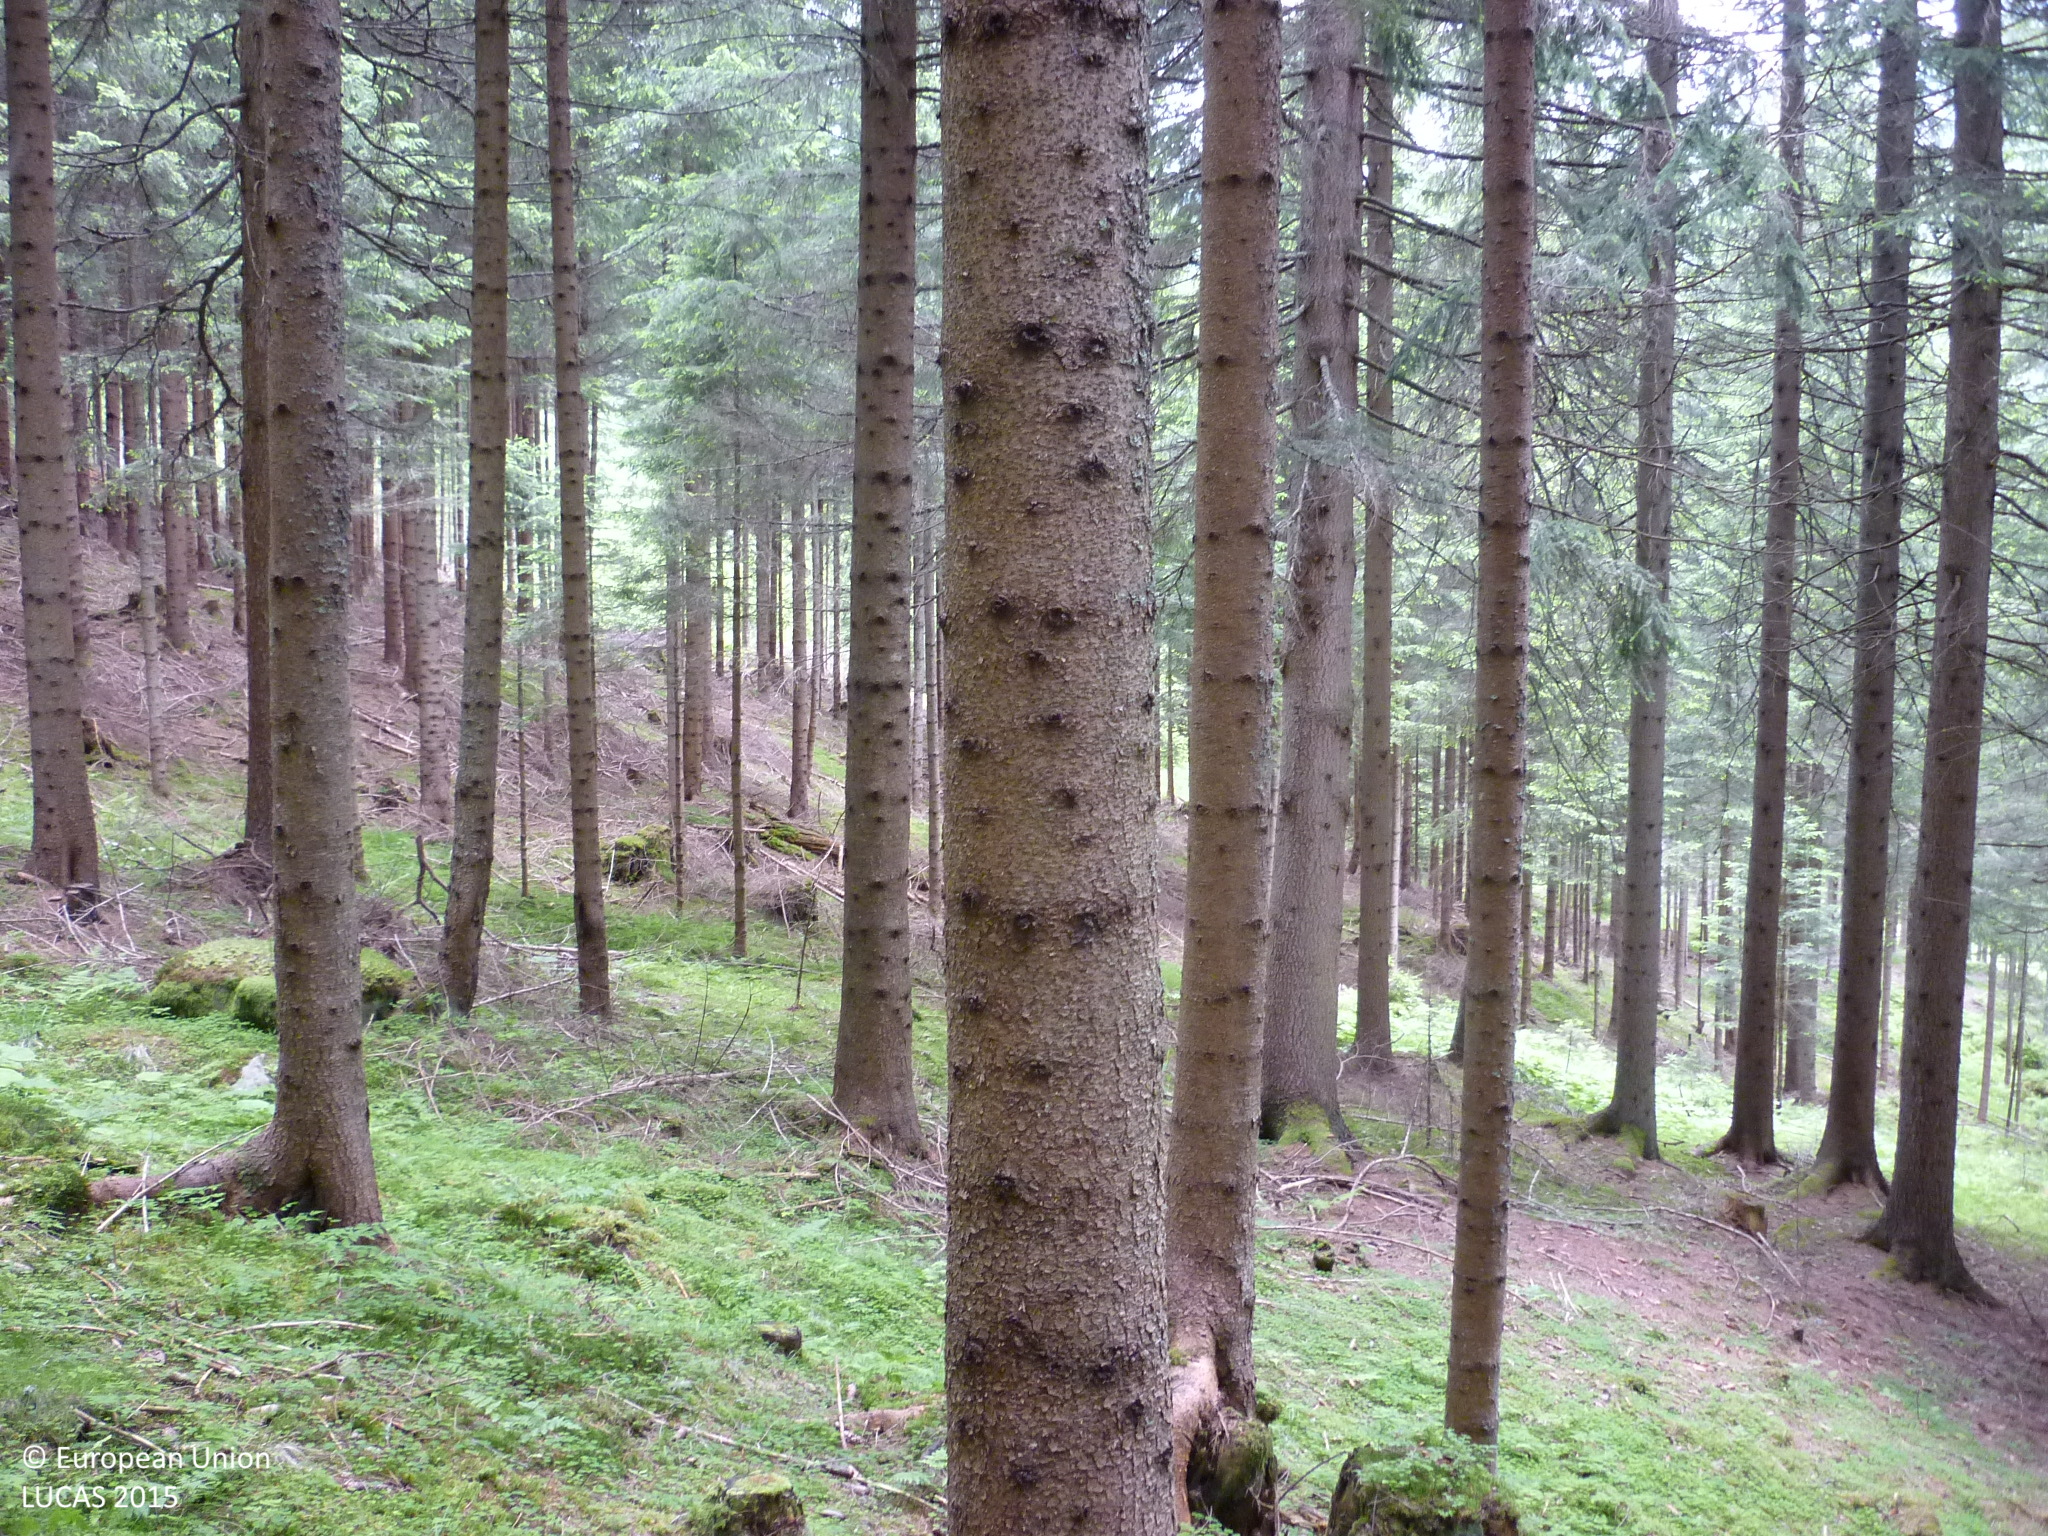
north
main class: Woodland
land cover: Spruce dominated coniferous woodland
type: alpine coniferous forest
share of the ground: > 75 %
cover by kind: coniferous forest trees 100 %
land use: Forestry
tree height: > 5 m
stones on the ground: < 10 %
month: June
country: AT
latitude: 47.2578
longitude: 14.2669
